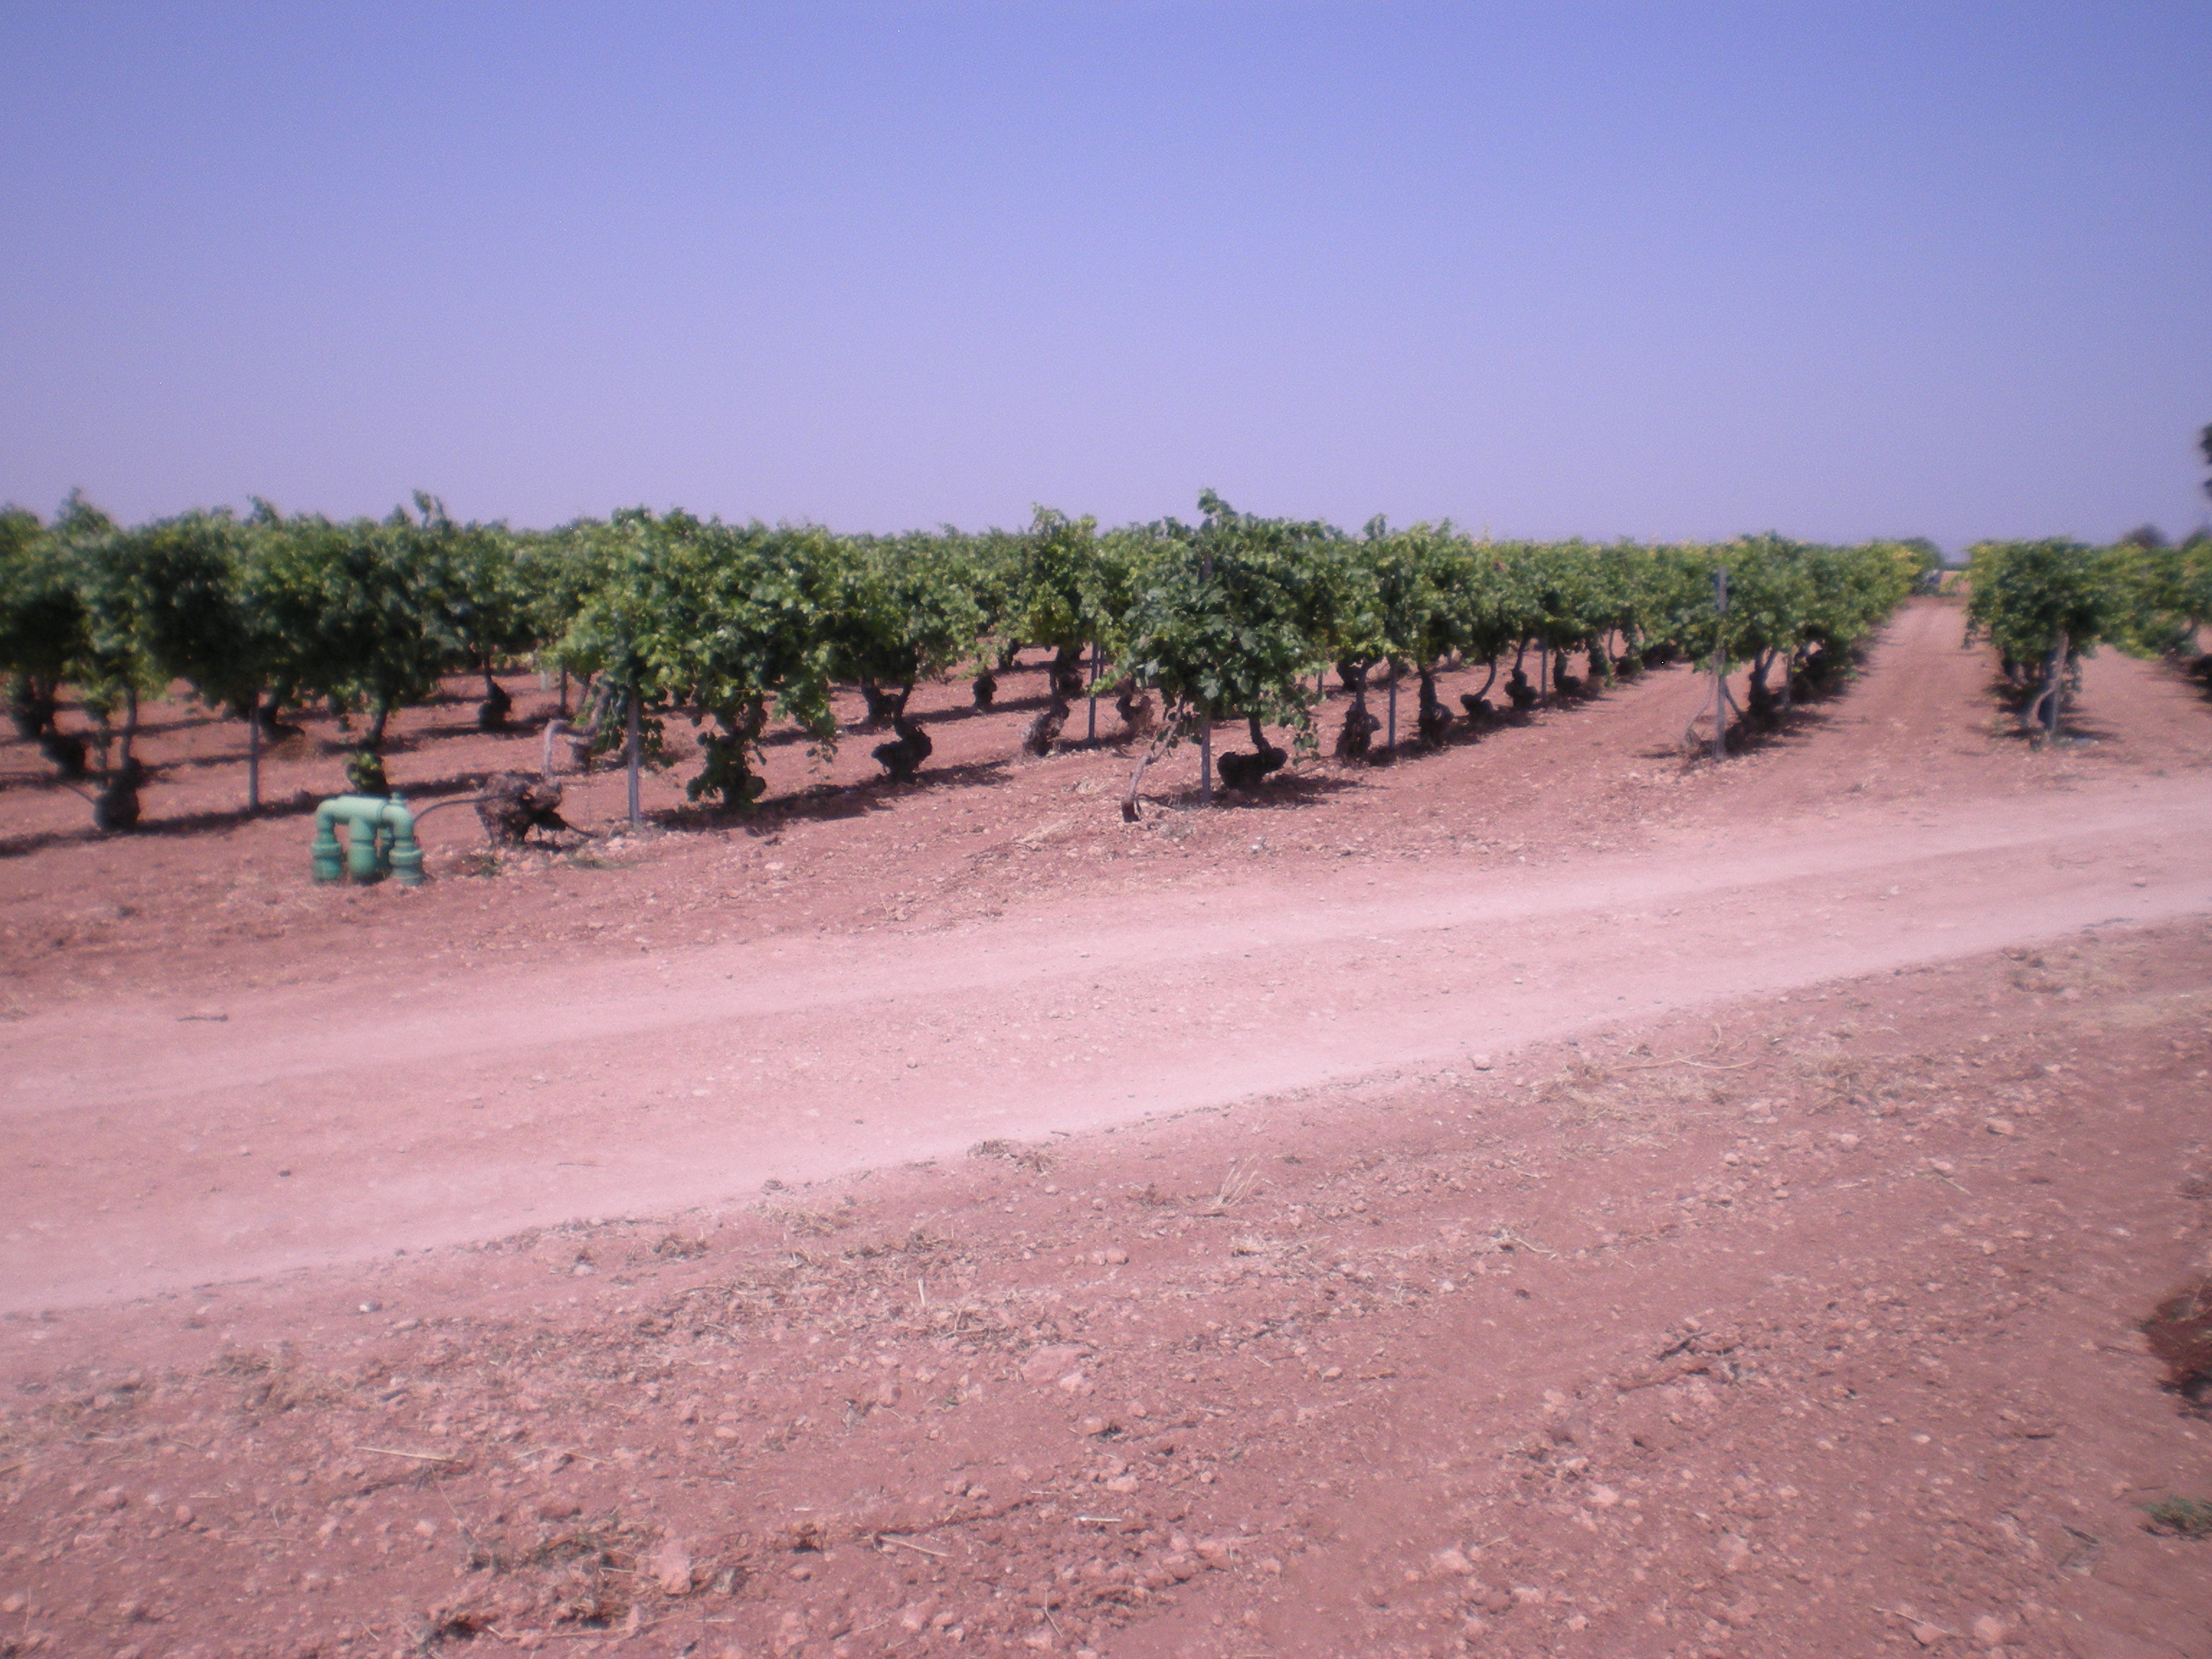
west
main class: Cropland
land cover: Vineyards
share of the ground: 10 - 25 %
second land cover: Other bare soil
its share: > 75 %
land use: Agriculture (excluding fallow land and kitchen gardens)
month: July
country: ES
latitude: 39.2140
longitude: -3.2772
